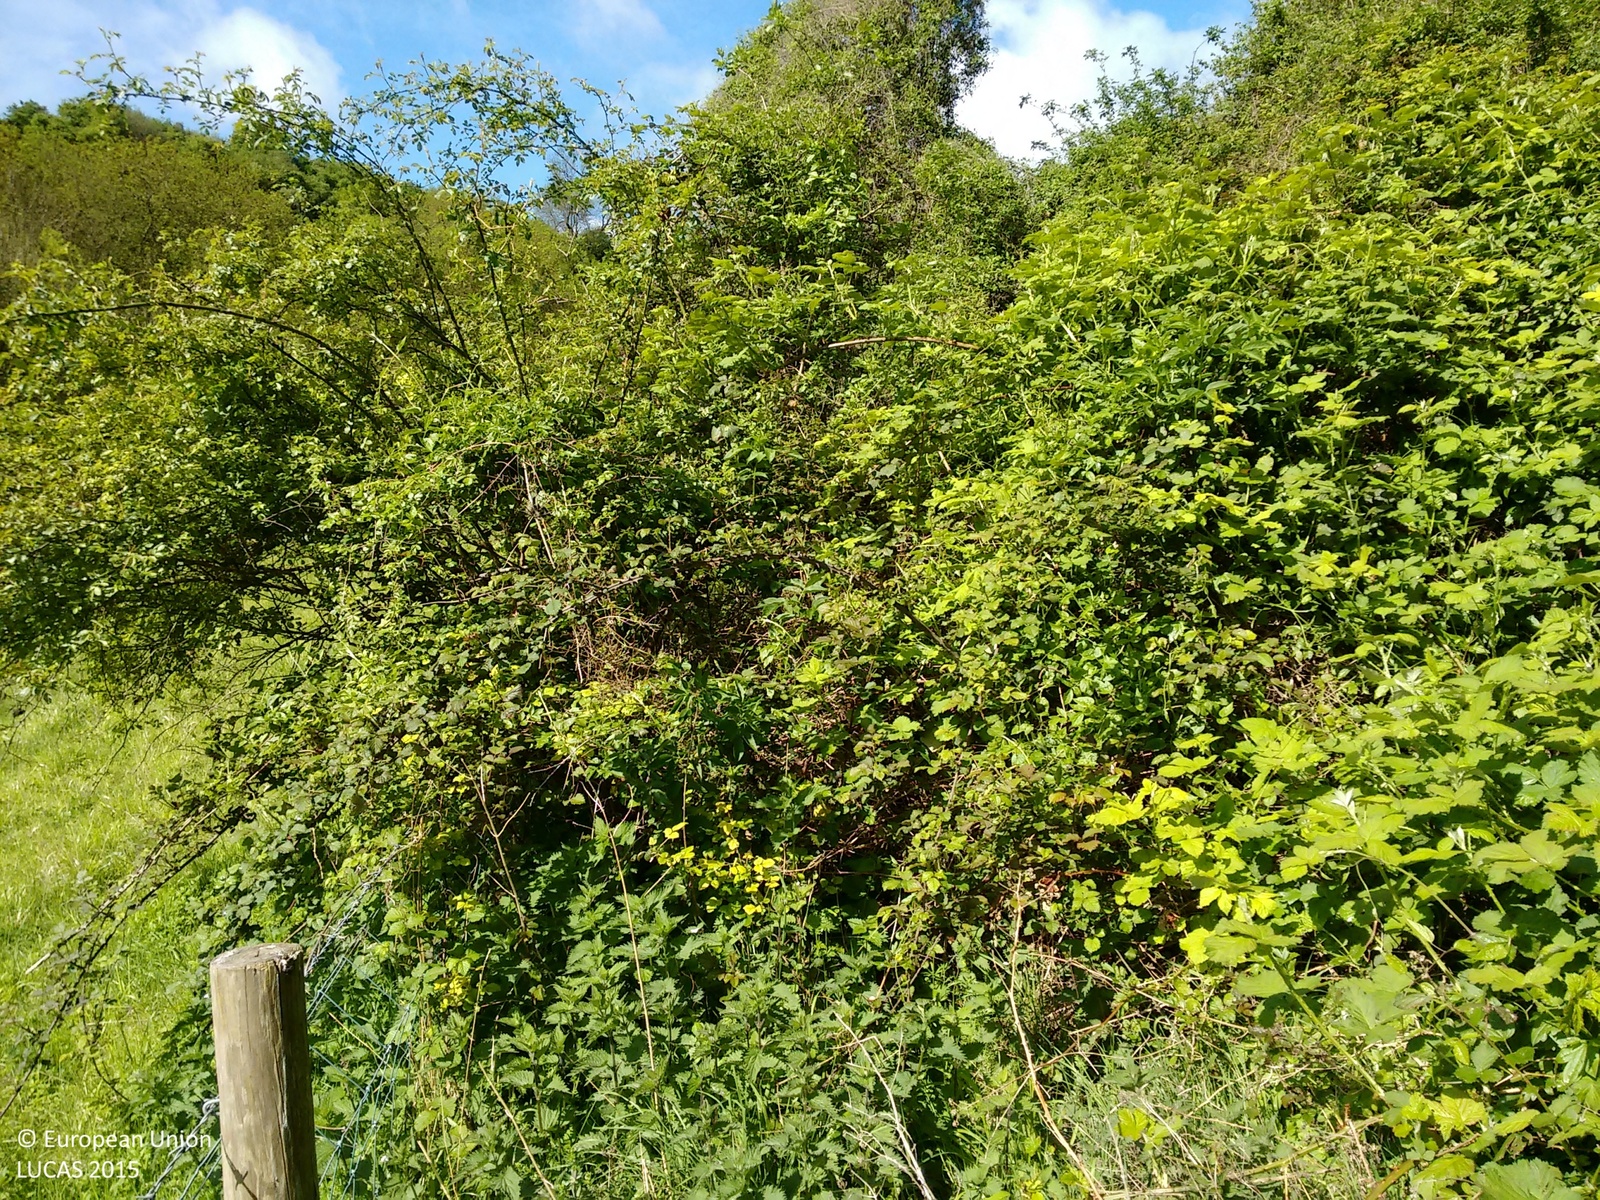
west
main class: Woodland
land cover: Broadleaved woodland
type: mesophytic deciduous forest
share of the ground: > 75 %
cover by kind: broadleaved forest trees 80 %, herbaceous plants 20 %
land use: Semi-natural and natural areas not in use
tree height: > 5 m
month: May
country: GB
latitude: 51.9520
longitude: -0.4410
